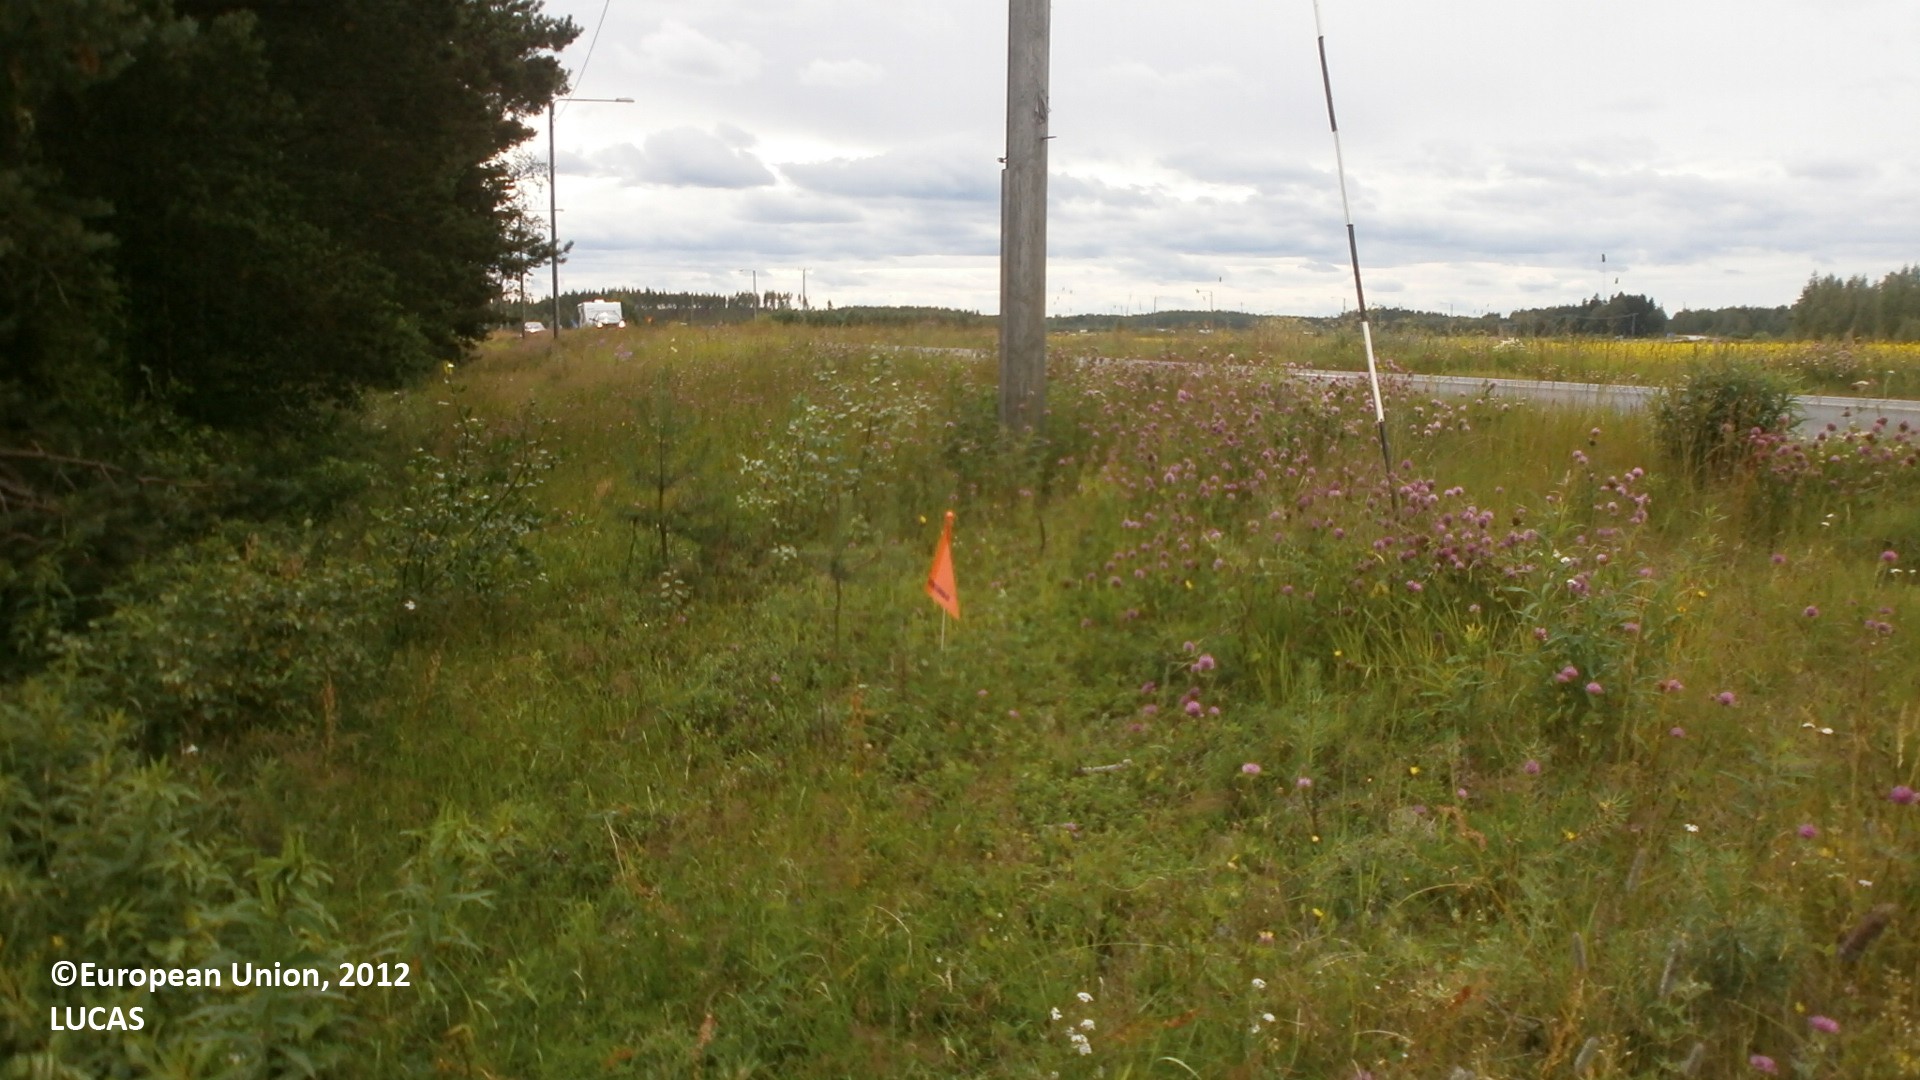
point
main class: Grassland
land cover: Spontaneously vegetated surfaces
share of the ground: > 75 %
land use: Road transport
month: July
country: FI
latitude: 63.9878
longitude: 24.2742
